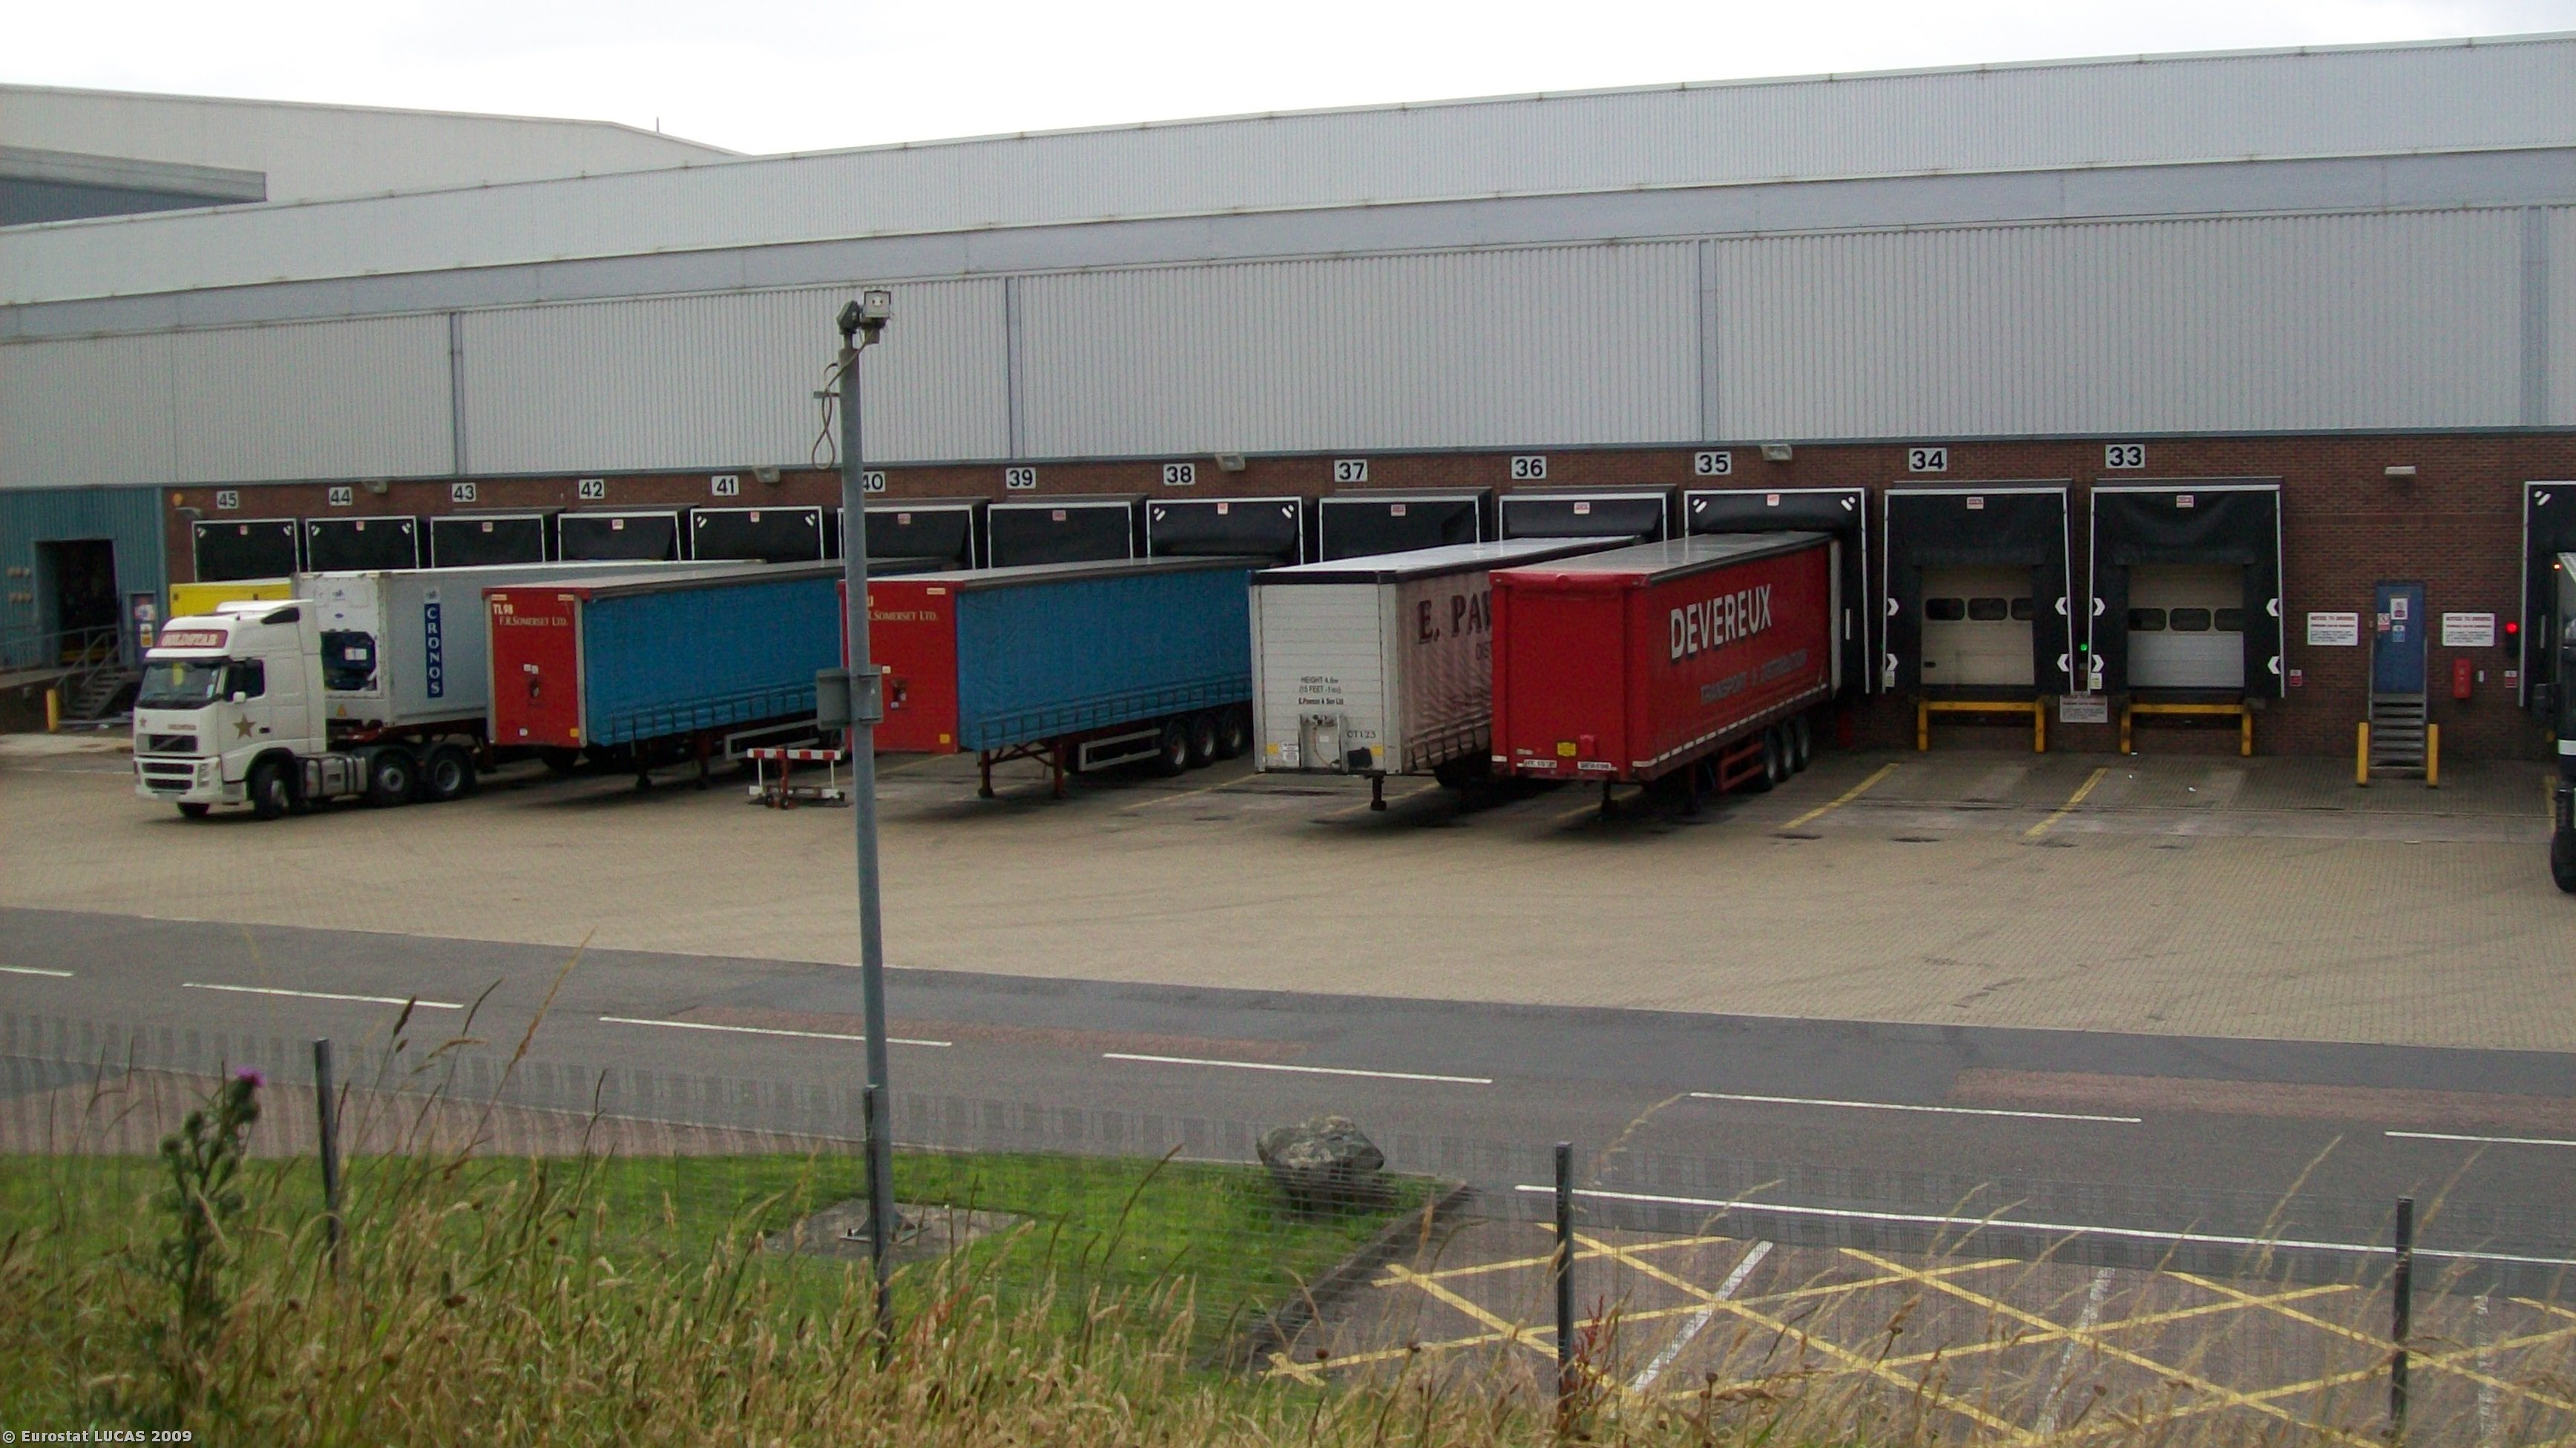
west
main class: Grassland
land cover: Grassland with sparse tree/shrub cover
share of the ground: > 75 %
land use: Unused
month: July
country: GB
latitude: 52.7038
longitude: -1.3405
